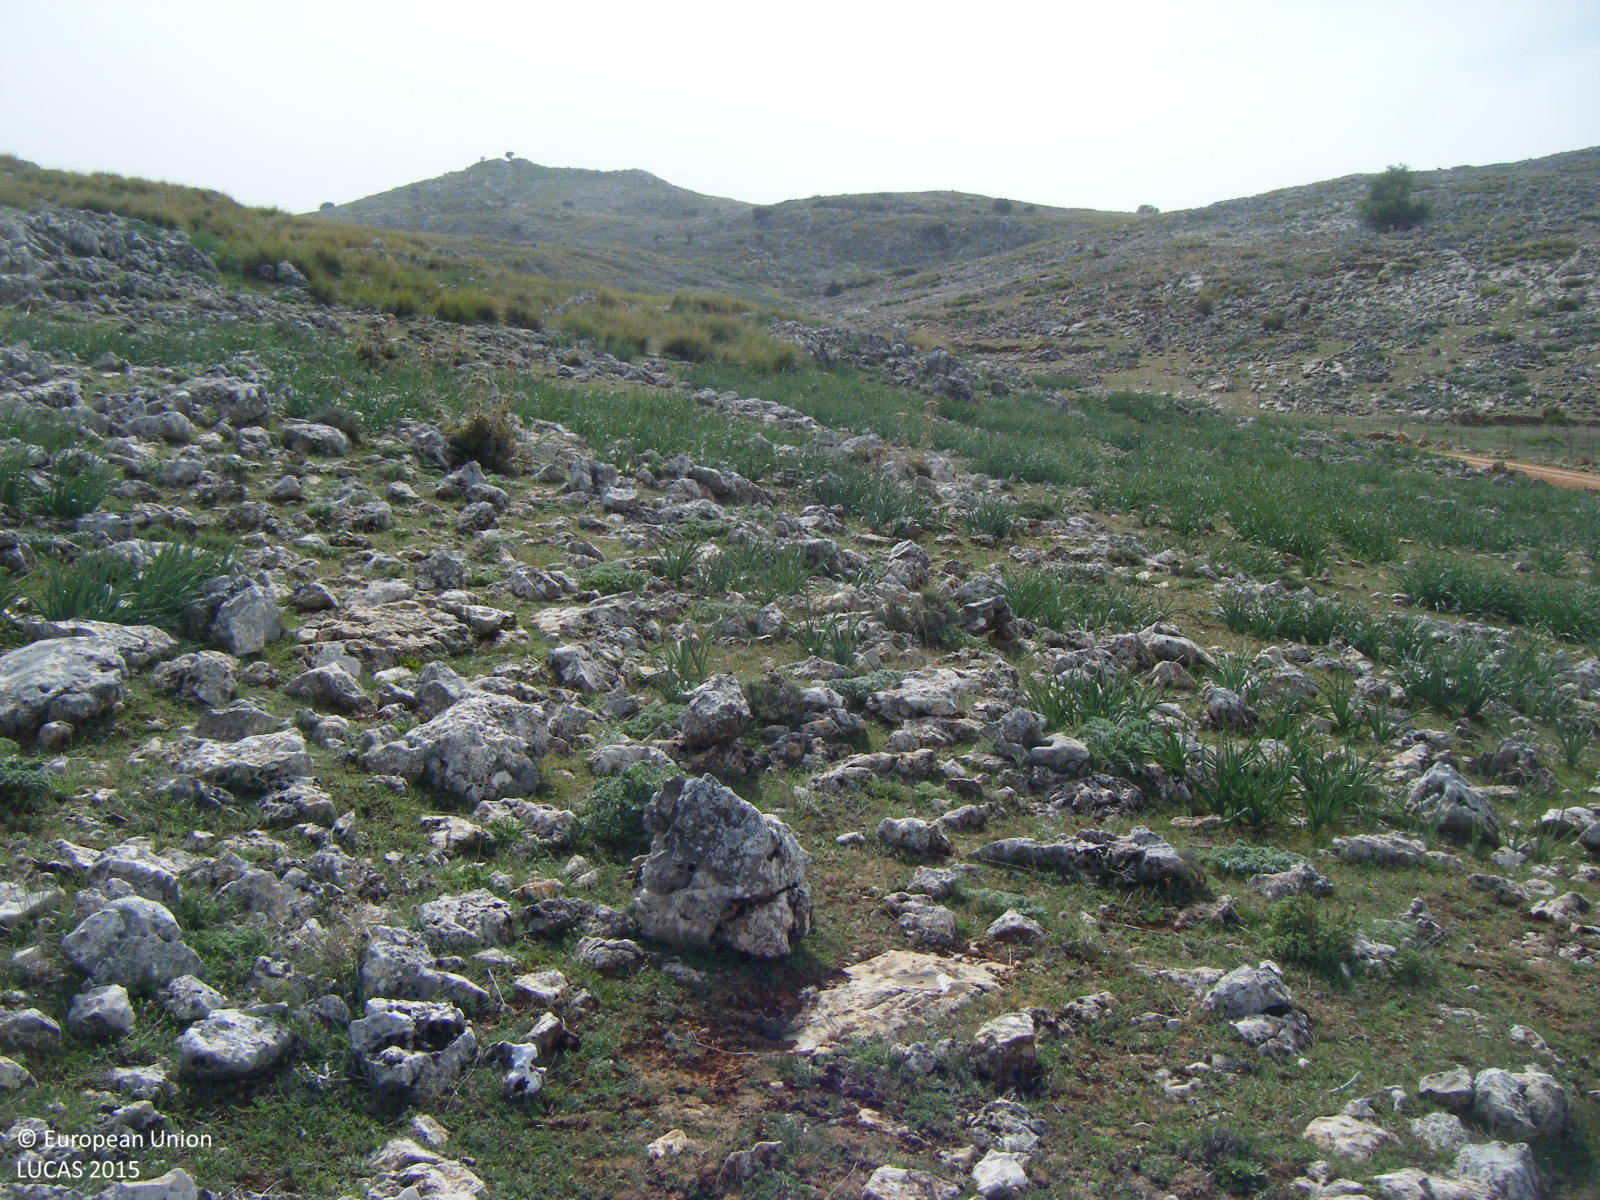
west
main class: Grassland
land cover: Grassland without tree/shrub cover
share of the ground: > 75 %
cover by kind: herbaceous plants 75 %, consolidated bare surface 25 %
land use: Agriculture (excluding fallow land and kitchen gardens)
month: April
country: ES
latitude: 37.0580
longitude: -4.1055
